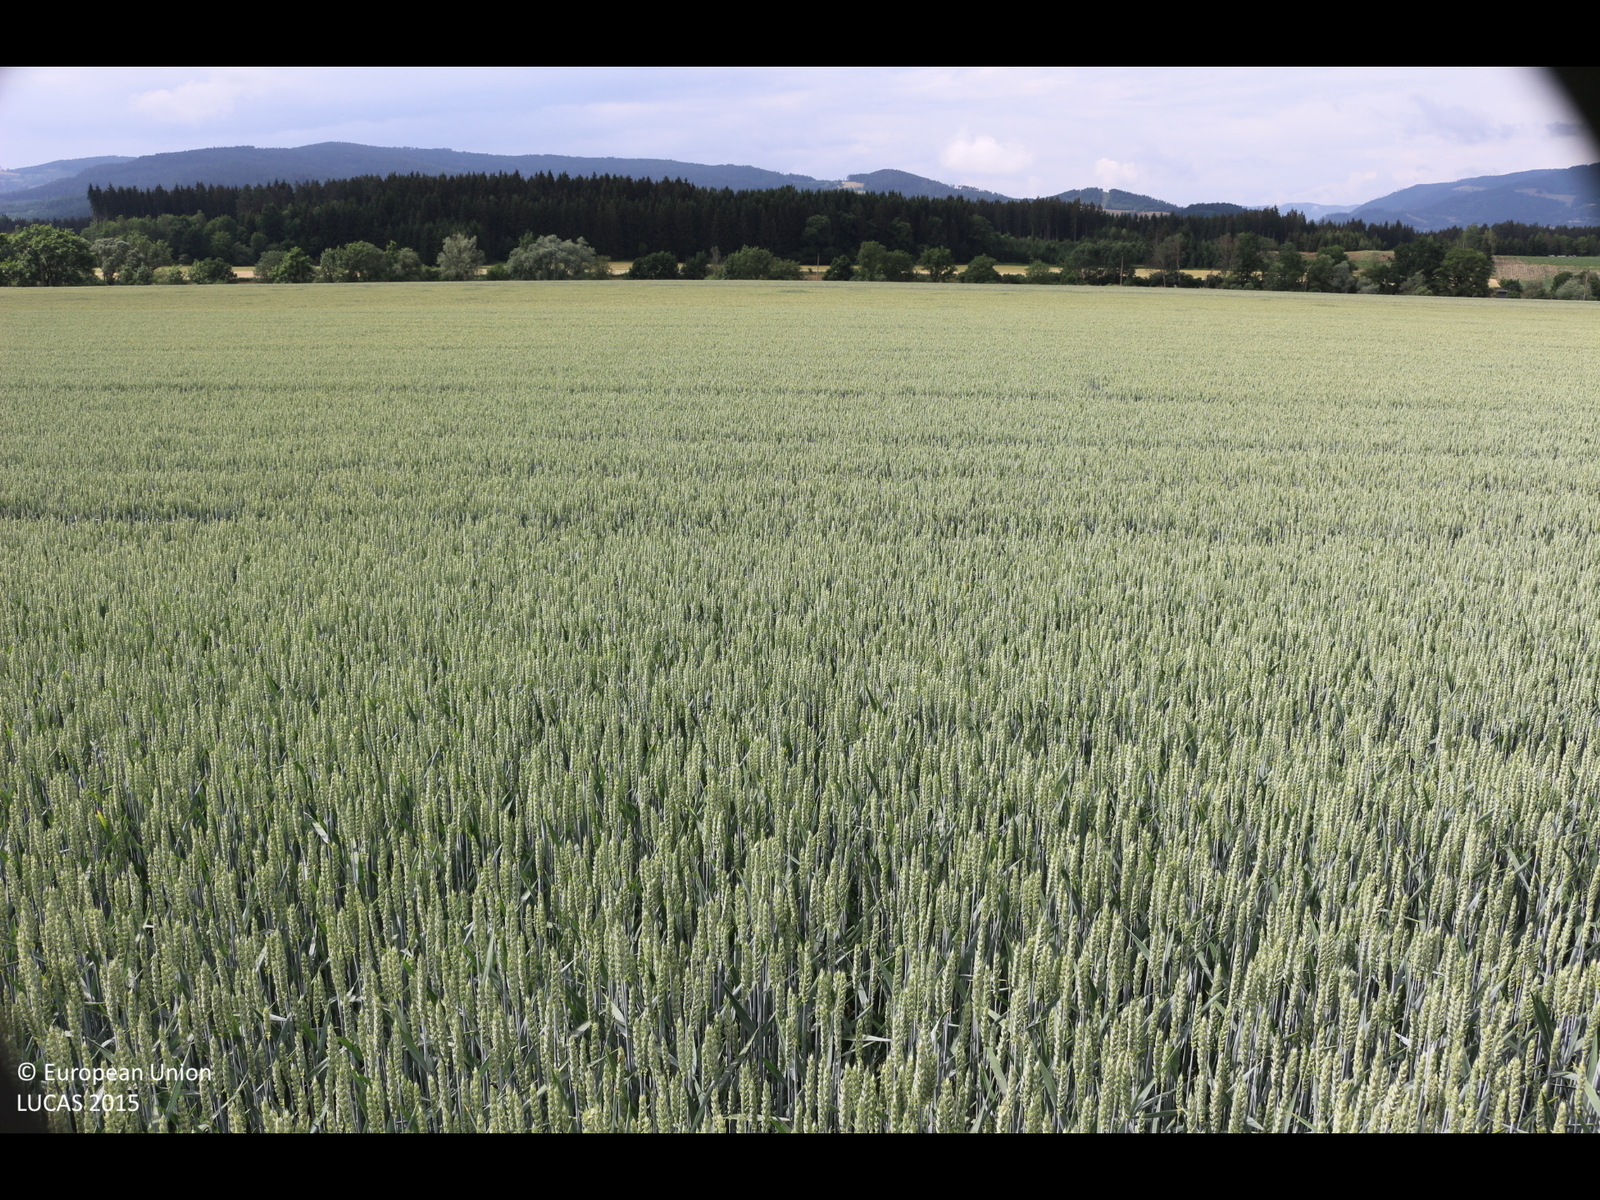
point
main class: Cropland
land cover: Common wheat
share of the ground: > 75 %
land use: Agriculture (excluding fallow land and kitchen gardens)
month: June
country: AT
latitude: 46.8361
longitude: 14.4426
